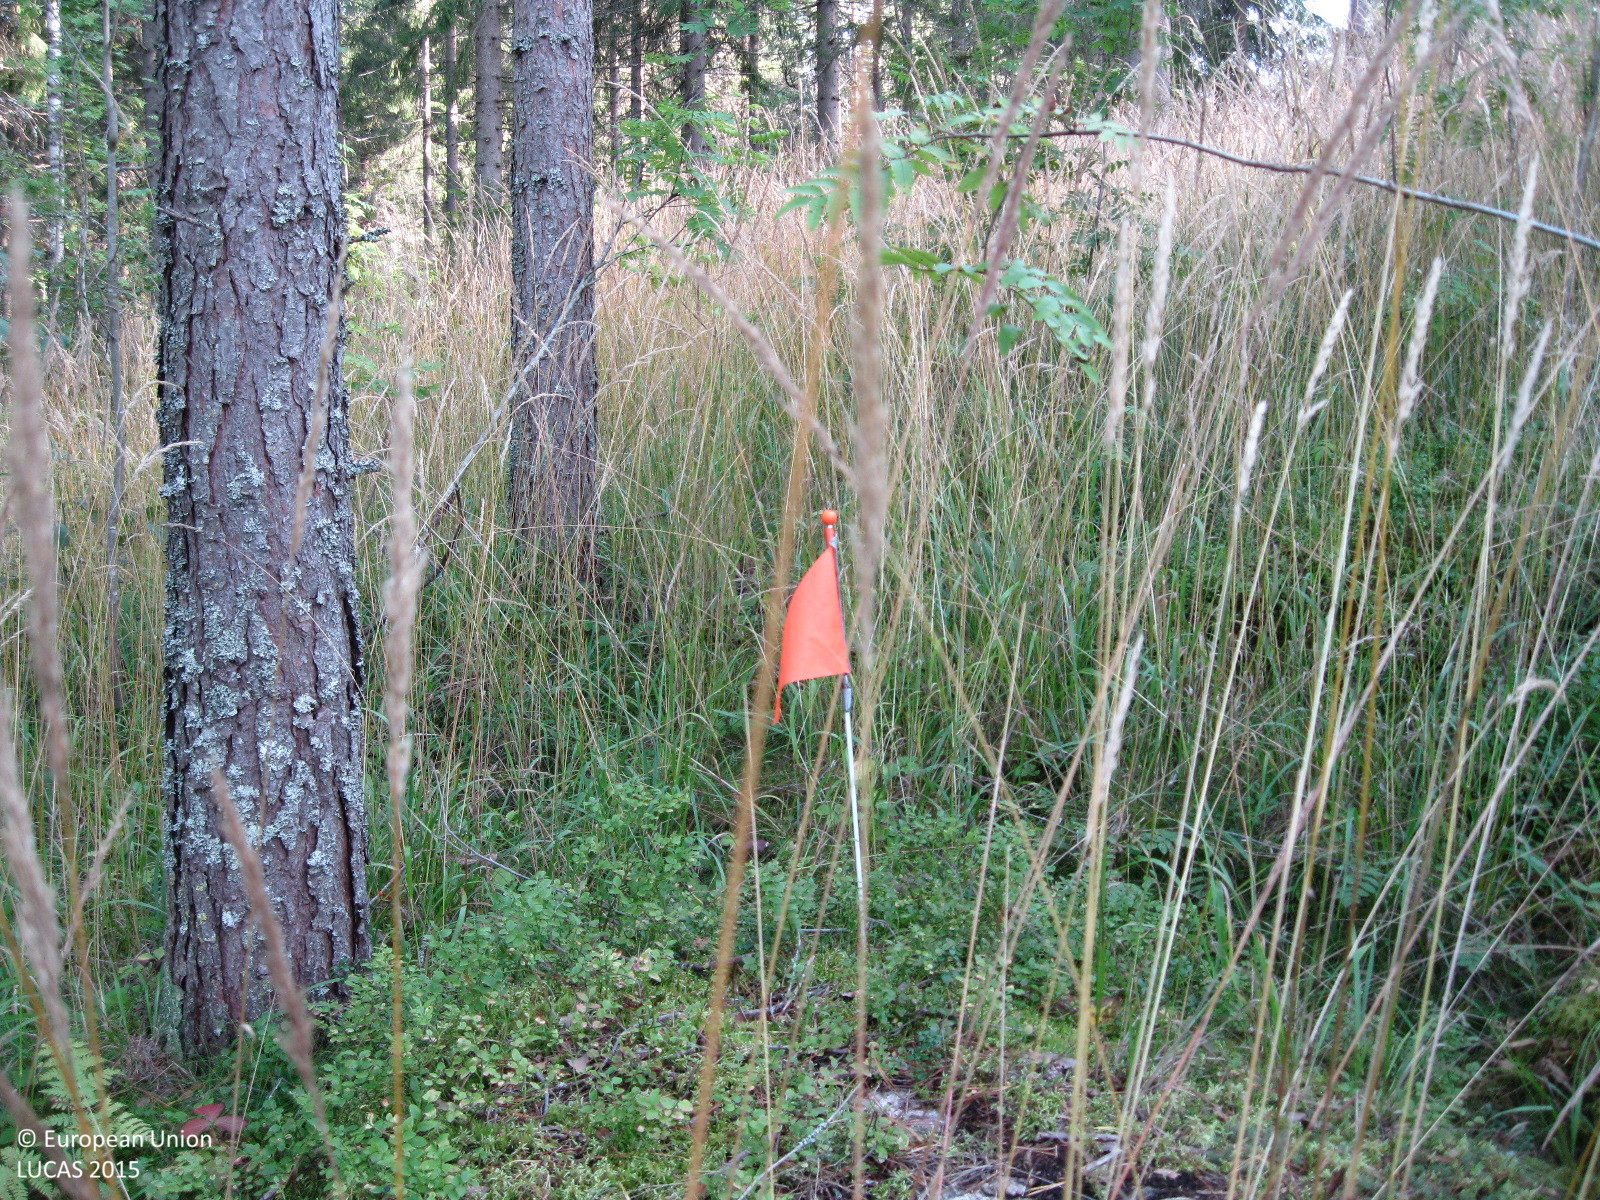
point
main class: Woodland
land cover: Pine dominated coniferous woodland
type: boreal forest
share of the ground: > 75 %
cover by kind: coniferous forest trees 70 %, herbaceous plants 25 %, broadleaved forest trees 5 %
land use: Forestry
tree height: > 5 m
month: September
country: FI
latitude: 60.5352
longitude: 24.5973
